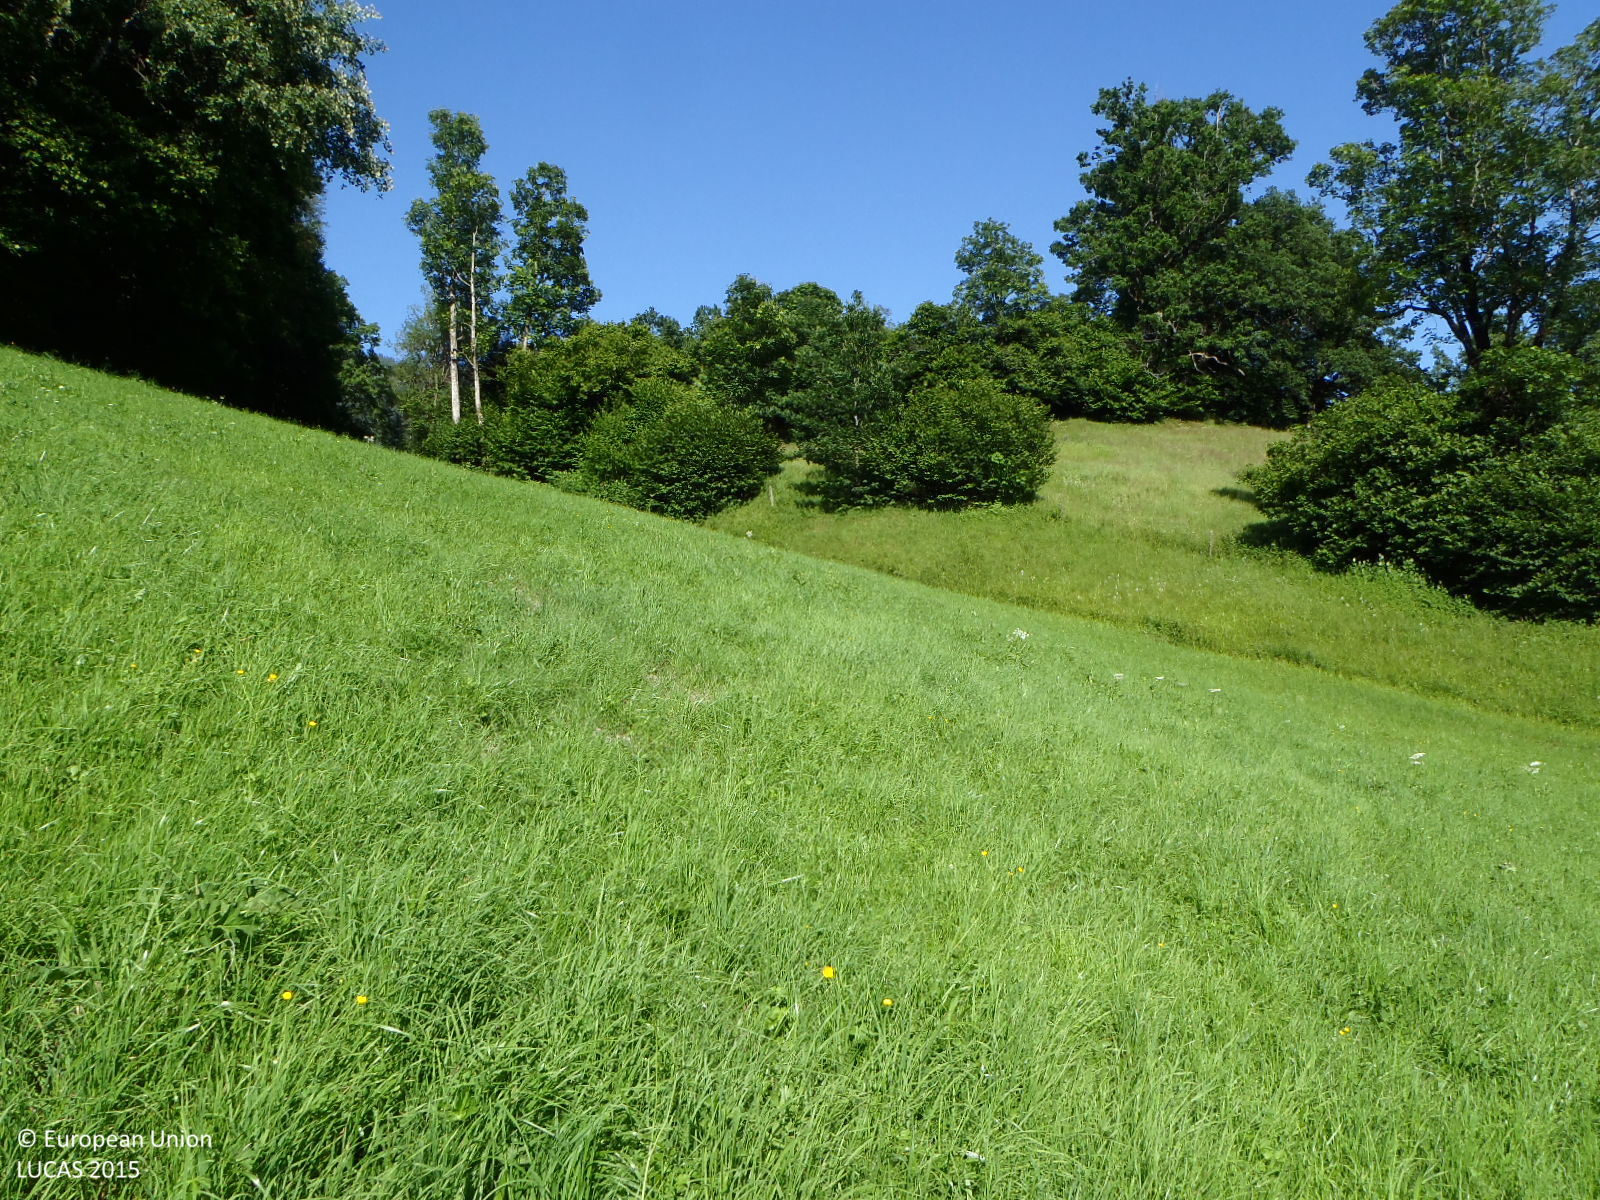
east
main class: Grassland
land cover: Grassland without tree/shrub cover
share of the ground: > 75 %
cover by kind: herbaceous plants 100 %
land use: Agriculture (excluding fallow land and kitchen gardens)
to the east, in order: Grassland without tree/shrub cover; Rivers and streams; Grassland without tree/shrub cover; Broadleaved woodland; Fences; Broadleaved woodland; Grassland without tree/shrub cover; Broadleaved woodland; Fences; Broadleaved woodland; Grassland without tree/shrub cover; Fences; Broadleaved woodland; Grassland without tree/shrub cover; Broadleaved woodland; Fences; Broadleaved woodland; Grassland without tree/shrub cover
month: July
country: AT
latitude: 47.4226
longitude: 12.4241
